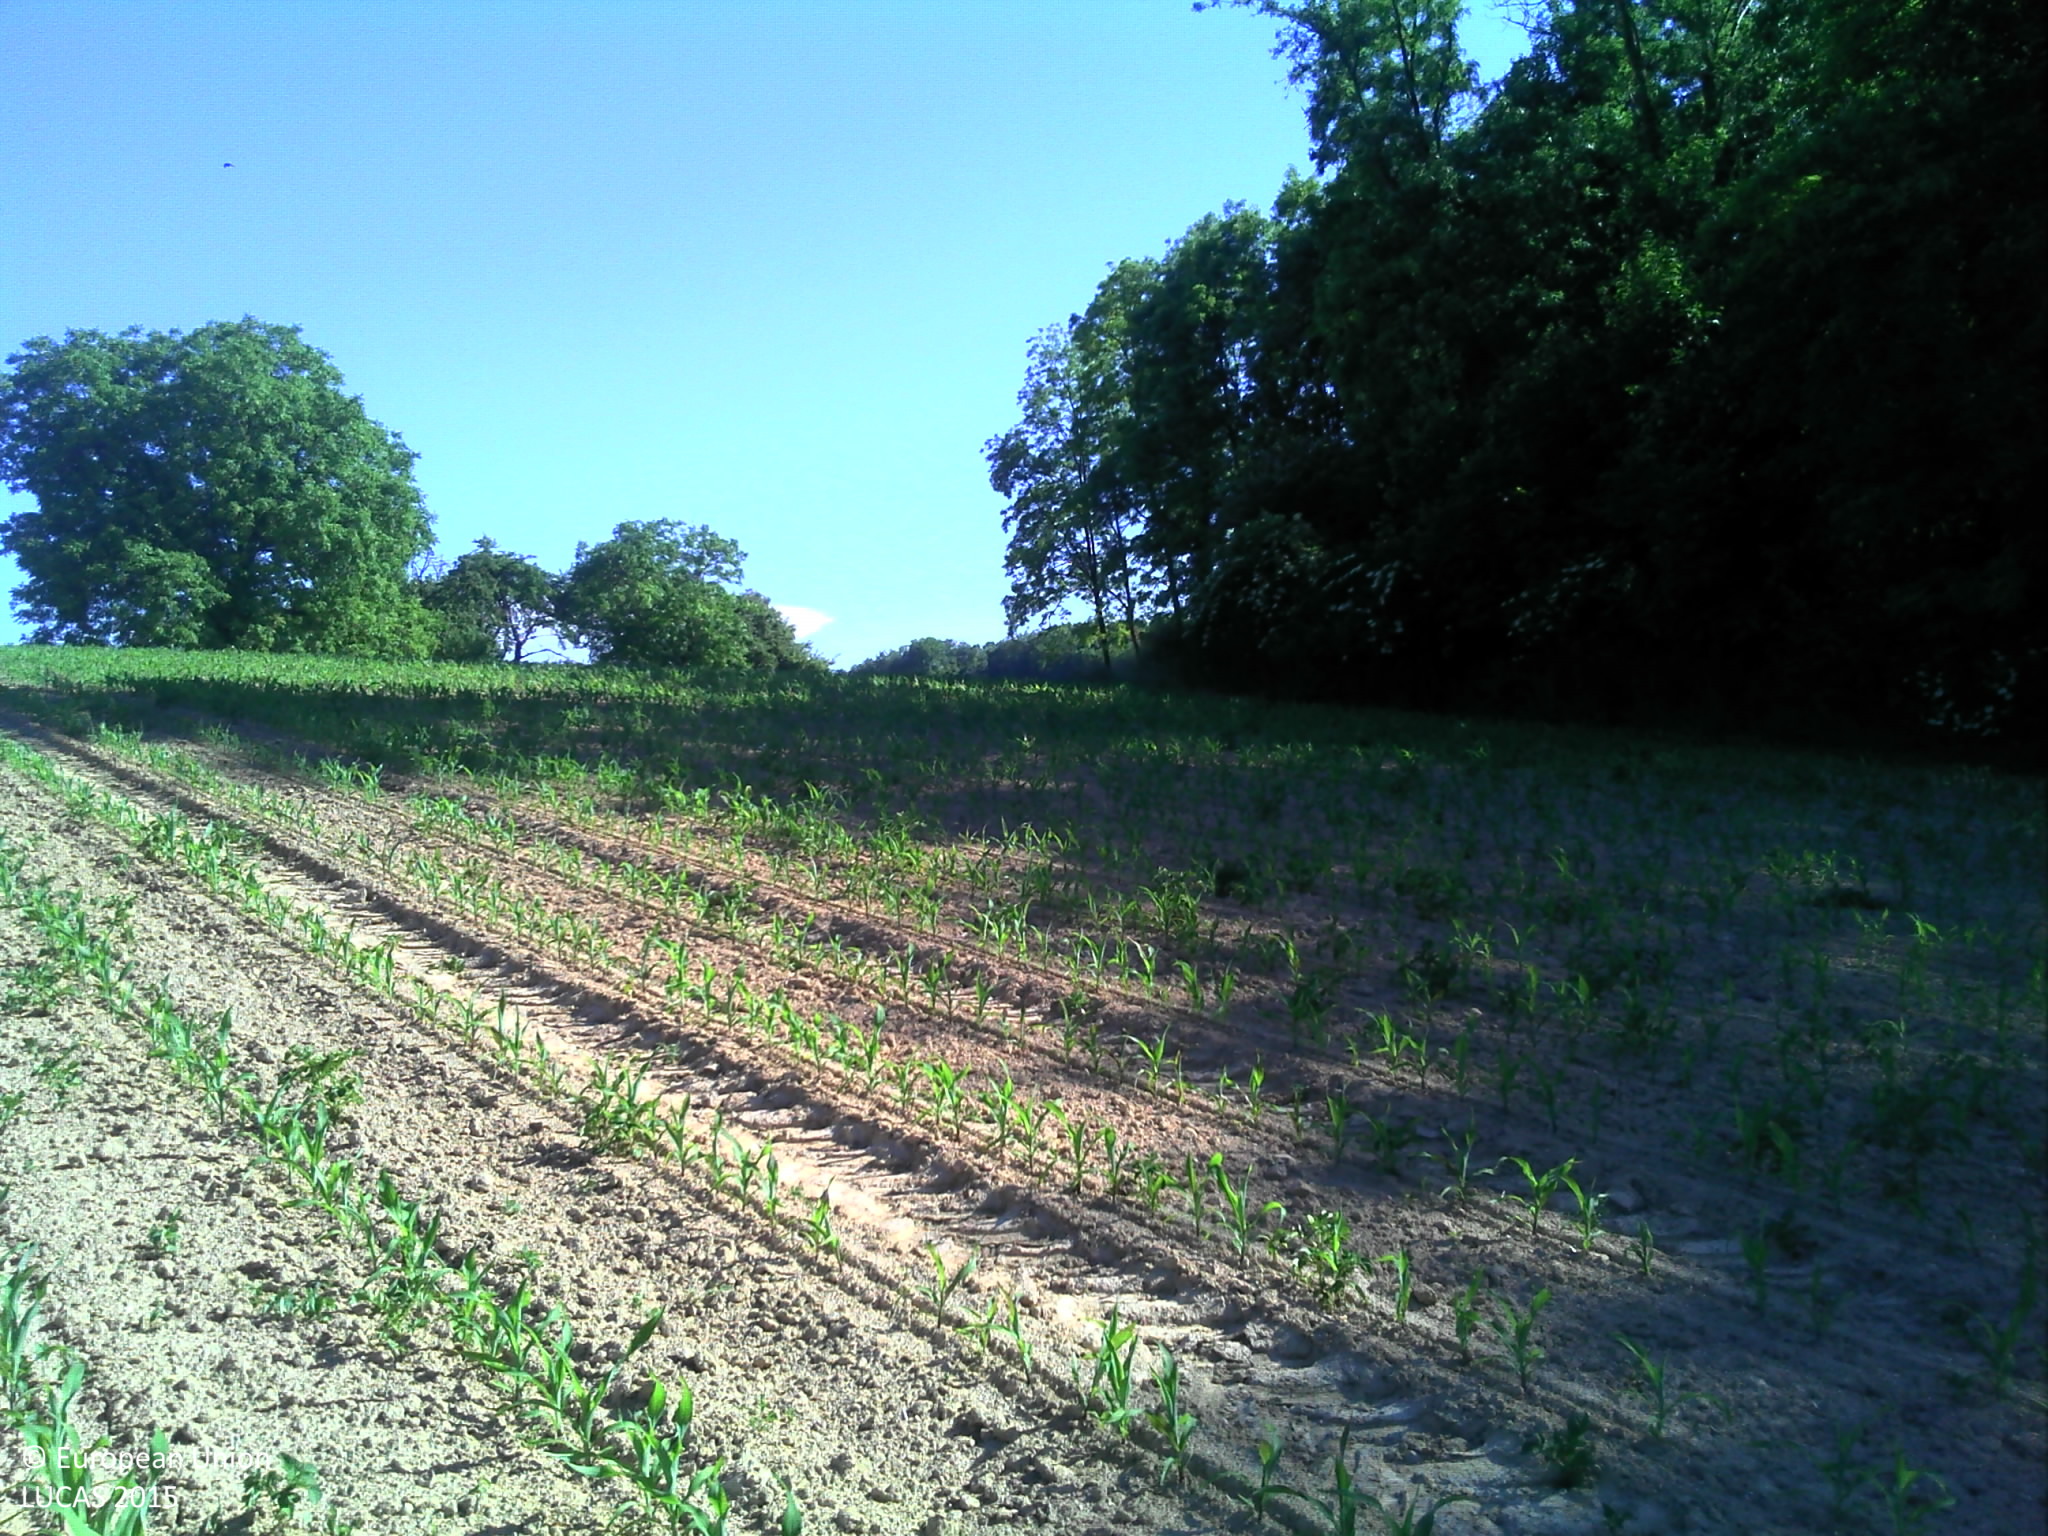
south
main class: Cropland
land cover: Maize
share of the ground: 10 - 25 %
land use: Agriculture (excluding fallow land and kitchen gardens)
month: June
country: FR
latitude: 47.6708
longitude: 7.4045
